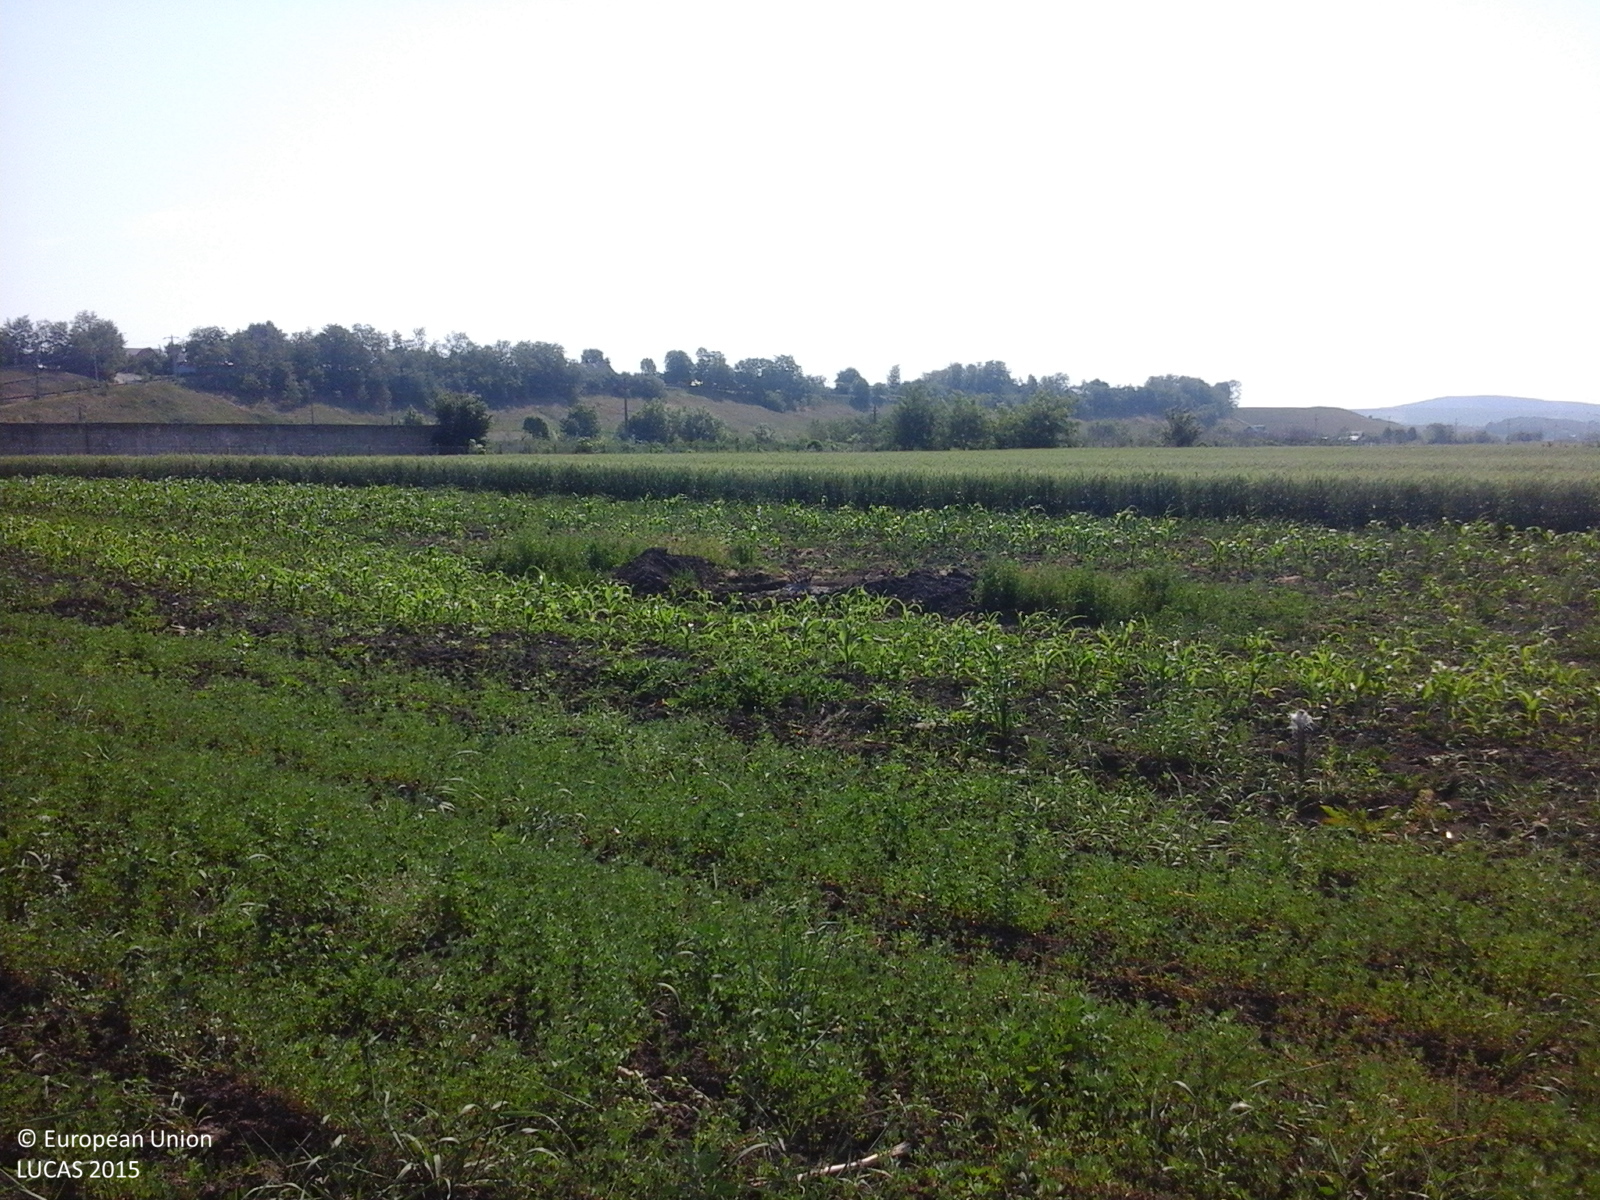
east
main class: Cropland
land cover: Lucerne
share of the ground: > 75 %
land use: Agriculture (excluding fallow land and kitchen gardens)
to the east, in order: Lucerne; Maize; Oats; Grass margins; Tracks; Grass margins; Fences; Electric lines; Spontaneously vegetated surfaces; Inland marshes; Spontaneously vegetated surfaces; Inland marshes; Spontaneously vegetated surfaces
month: June
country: RO
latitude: 46.8301
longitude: 26.5650
